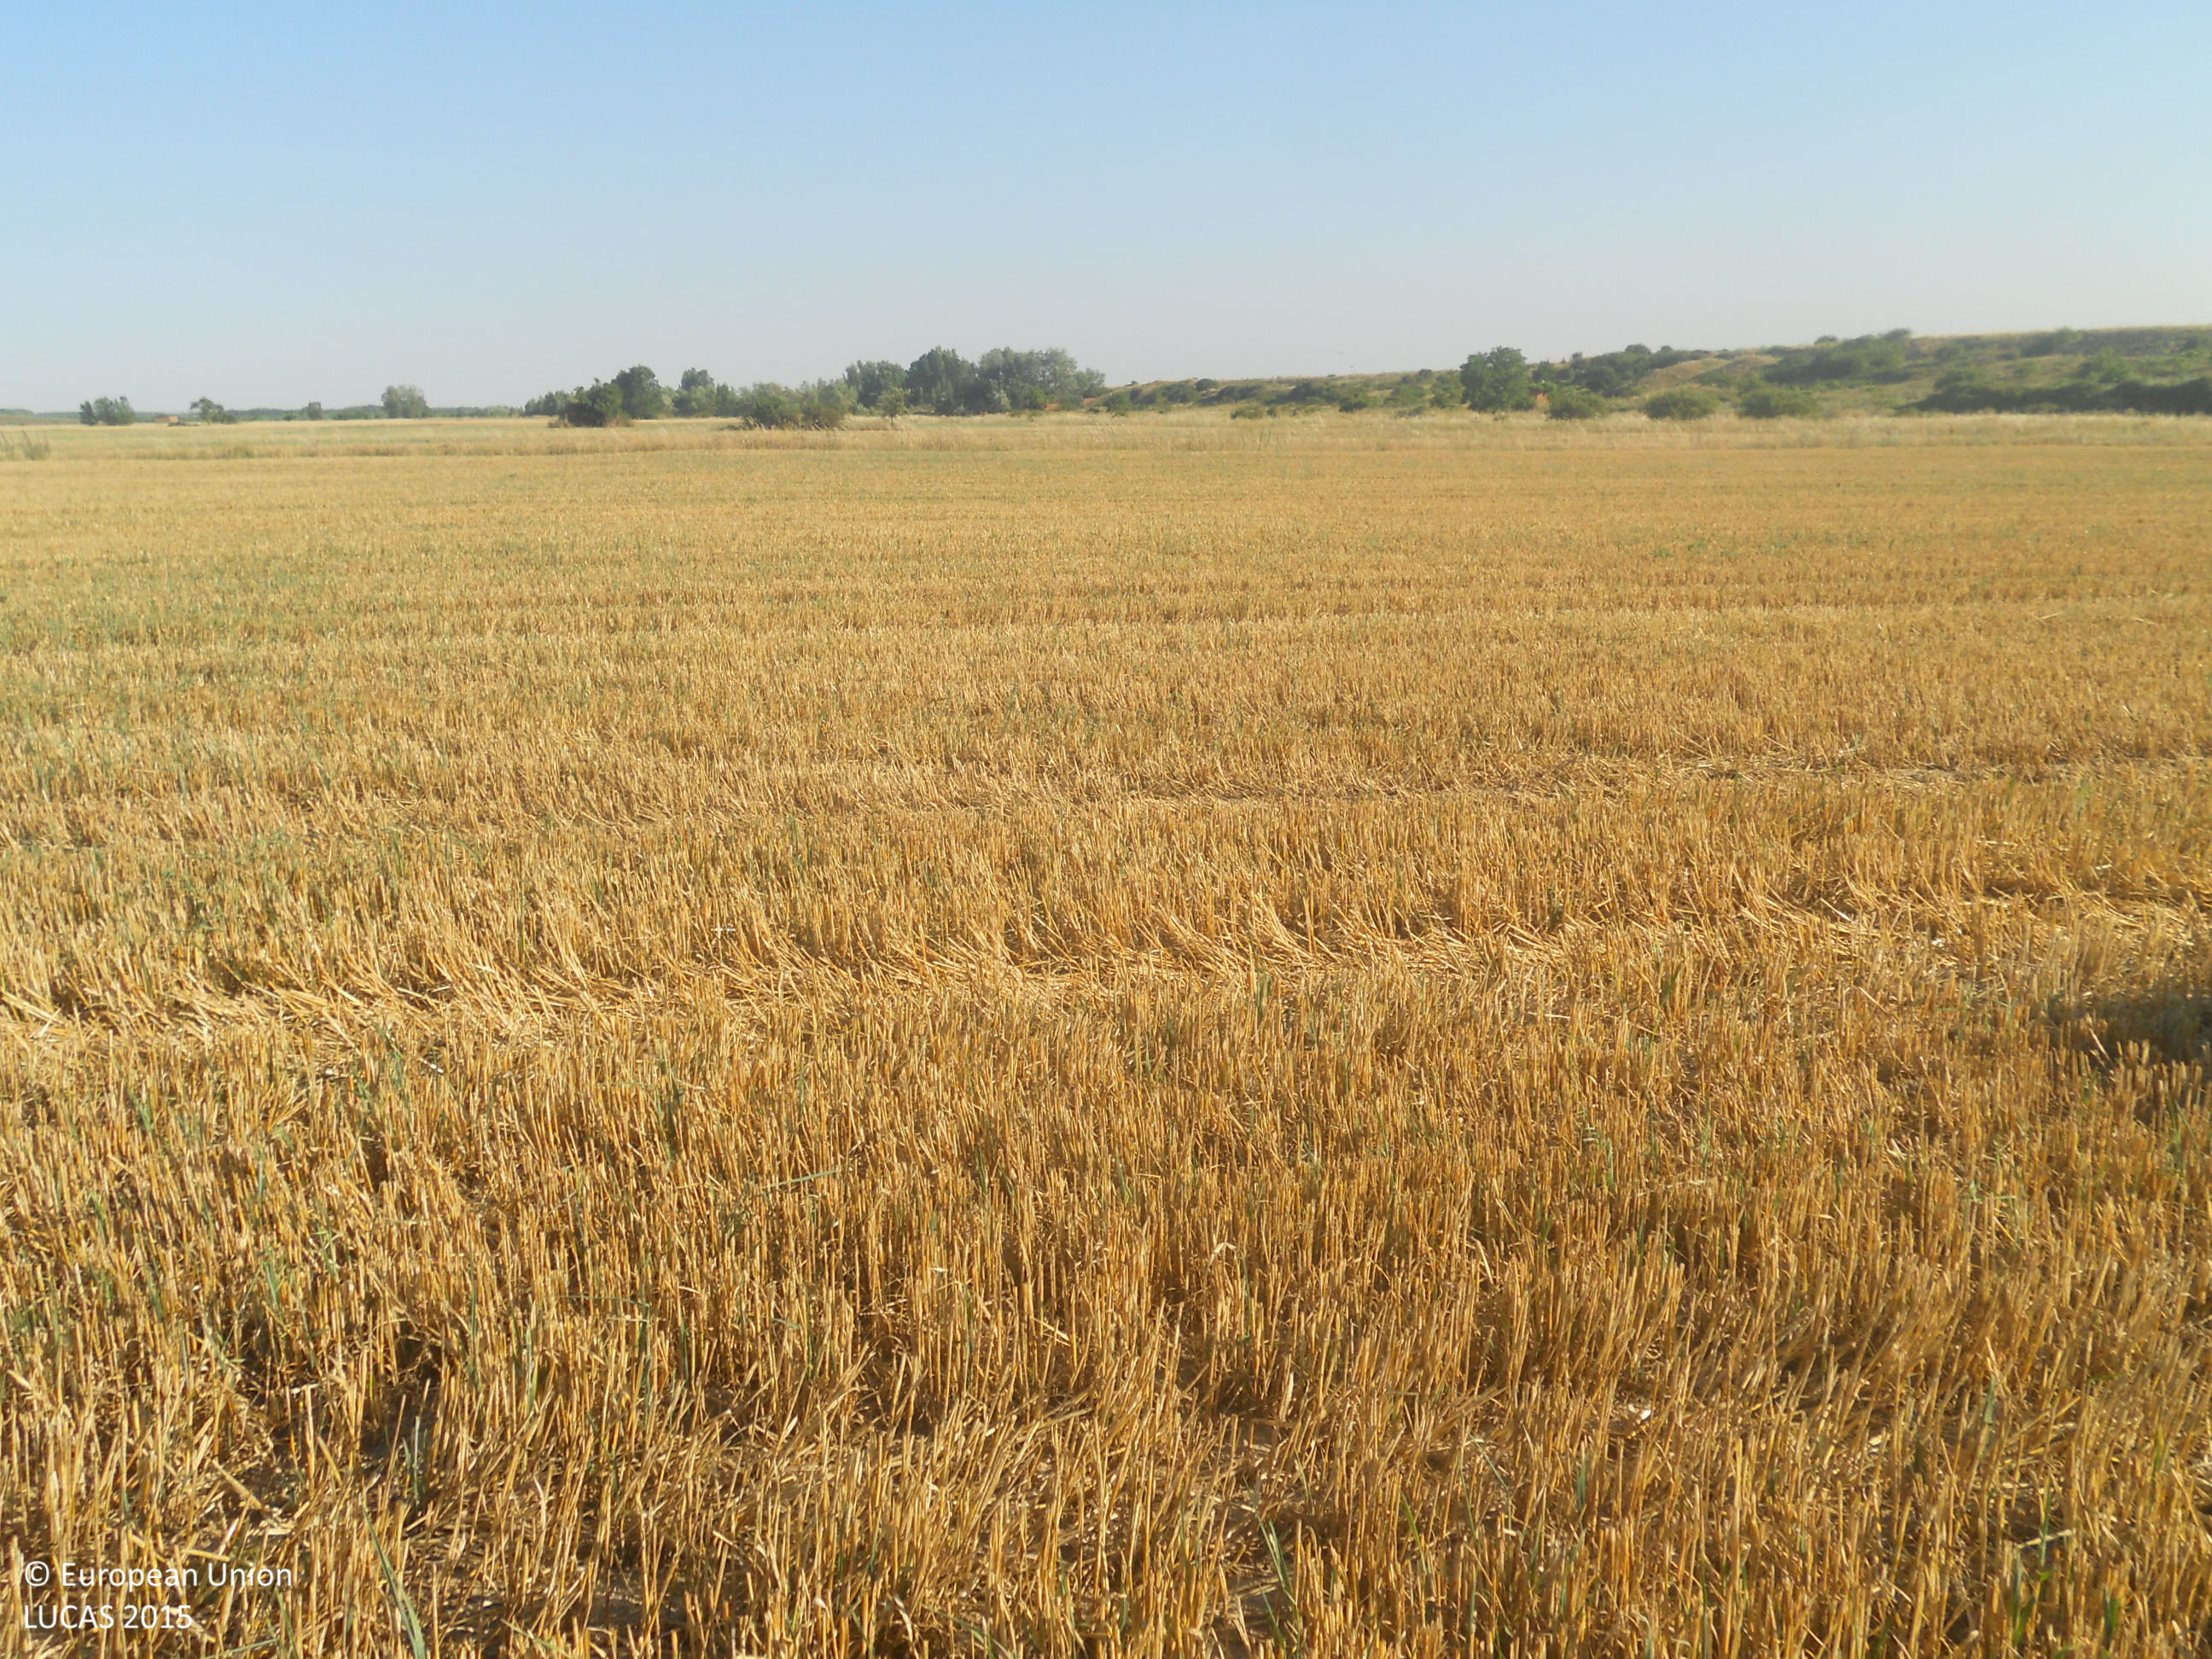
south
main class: Cropland
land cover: Oats
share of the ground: > 75 %
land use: Agriculture (excluding fallow land and kitchen gardens)
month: July
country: ES
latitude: 42.5070
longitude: -5.5638
